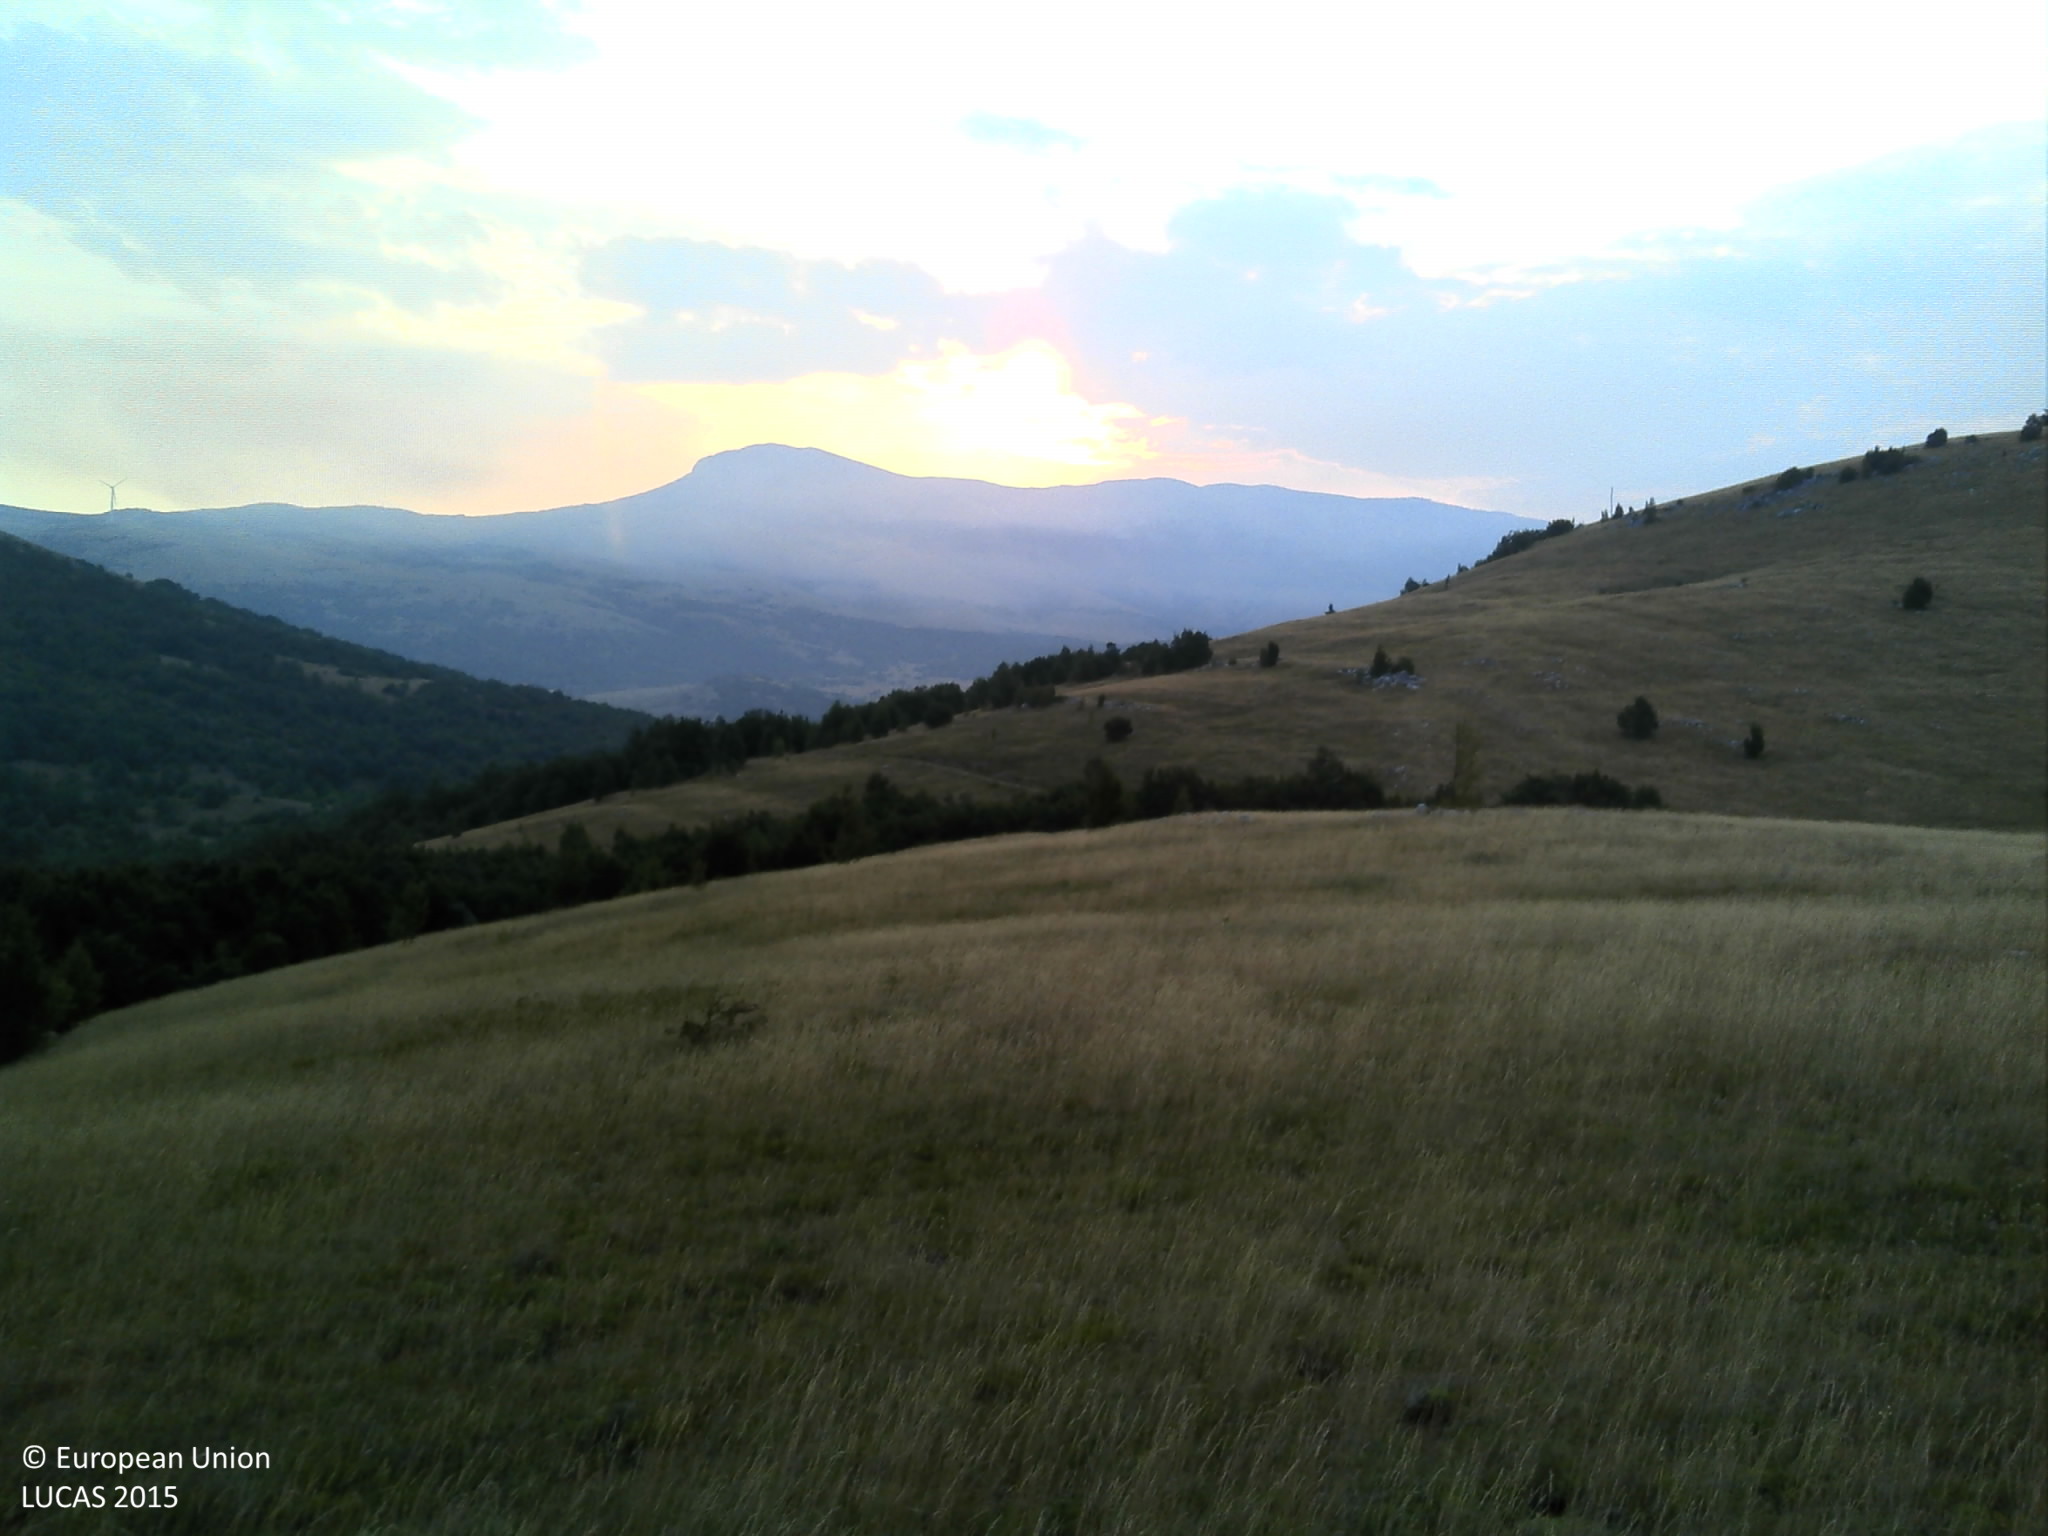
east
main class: Grassland
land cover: Grassland without tree/shrub cover
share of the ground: > 75 %
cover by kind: herbaceous plants 95 %, shrubs 5 %
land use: Abandoned areas
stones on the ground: < 10 %
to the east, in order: Grassland without tree/shrub cover; Rock outcrops; Grassland with sparse tree/shrub cover; Tracks; Grassland with sparse tree/shrub cover; Rock outcrops
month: July
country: HR
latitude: 44.2289
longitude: 16.0397
